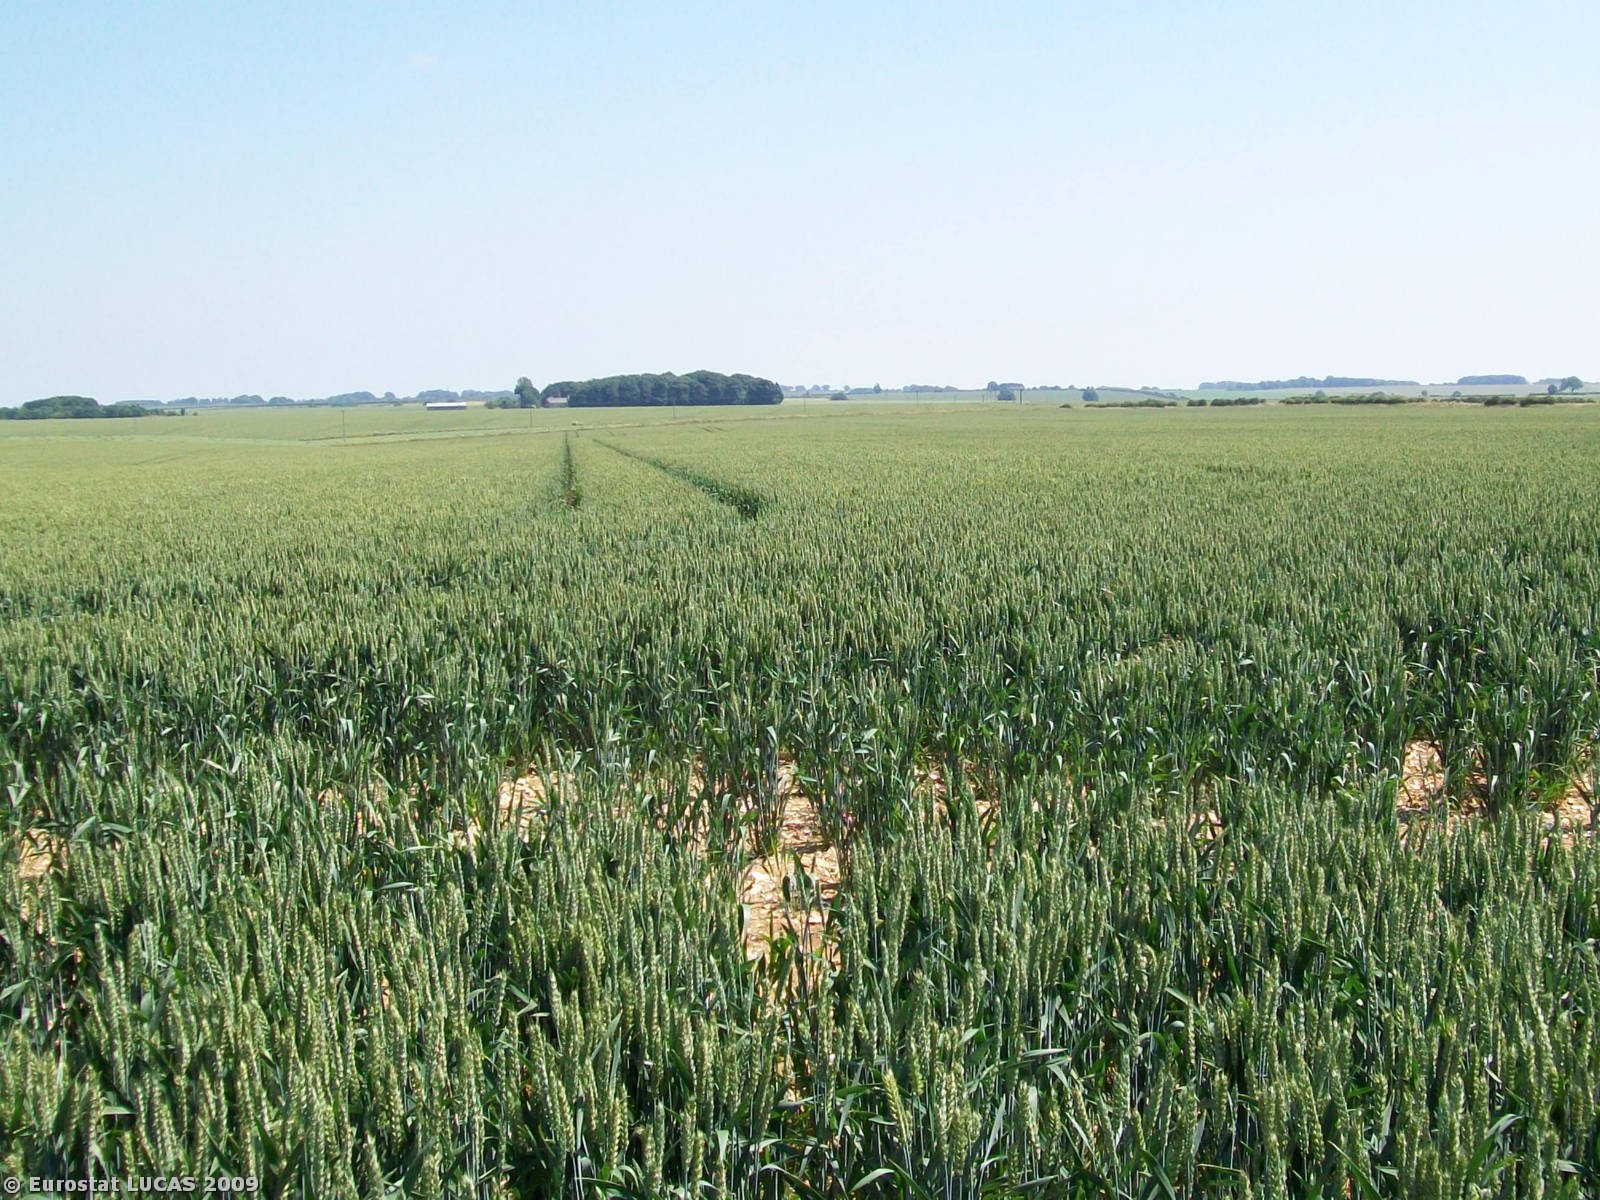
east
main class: Cropland
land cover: Common wheat
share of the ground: > 75 %
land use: Agriculture (excluding fallow land and kitchen gardens)
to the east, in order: Common wheat
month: July
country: GB
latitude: 53.3910
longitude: -0.1533
